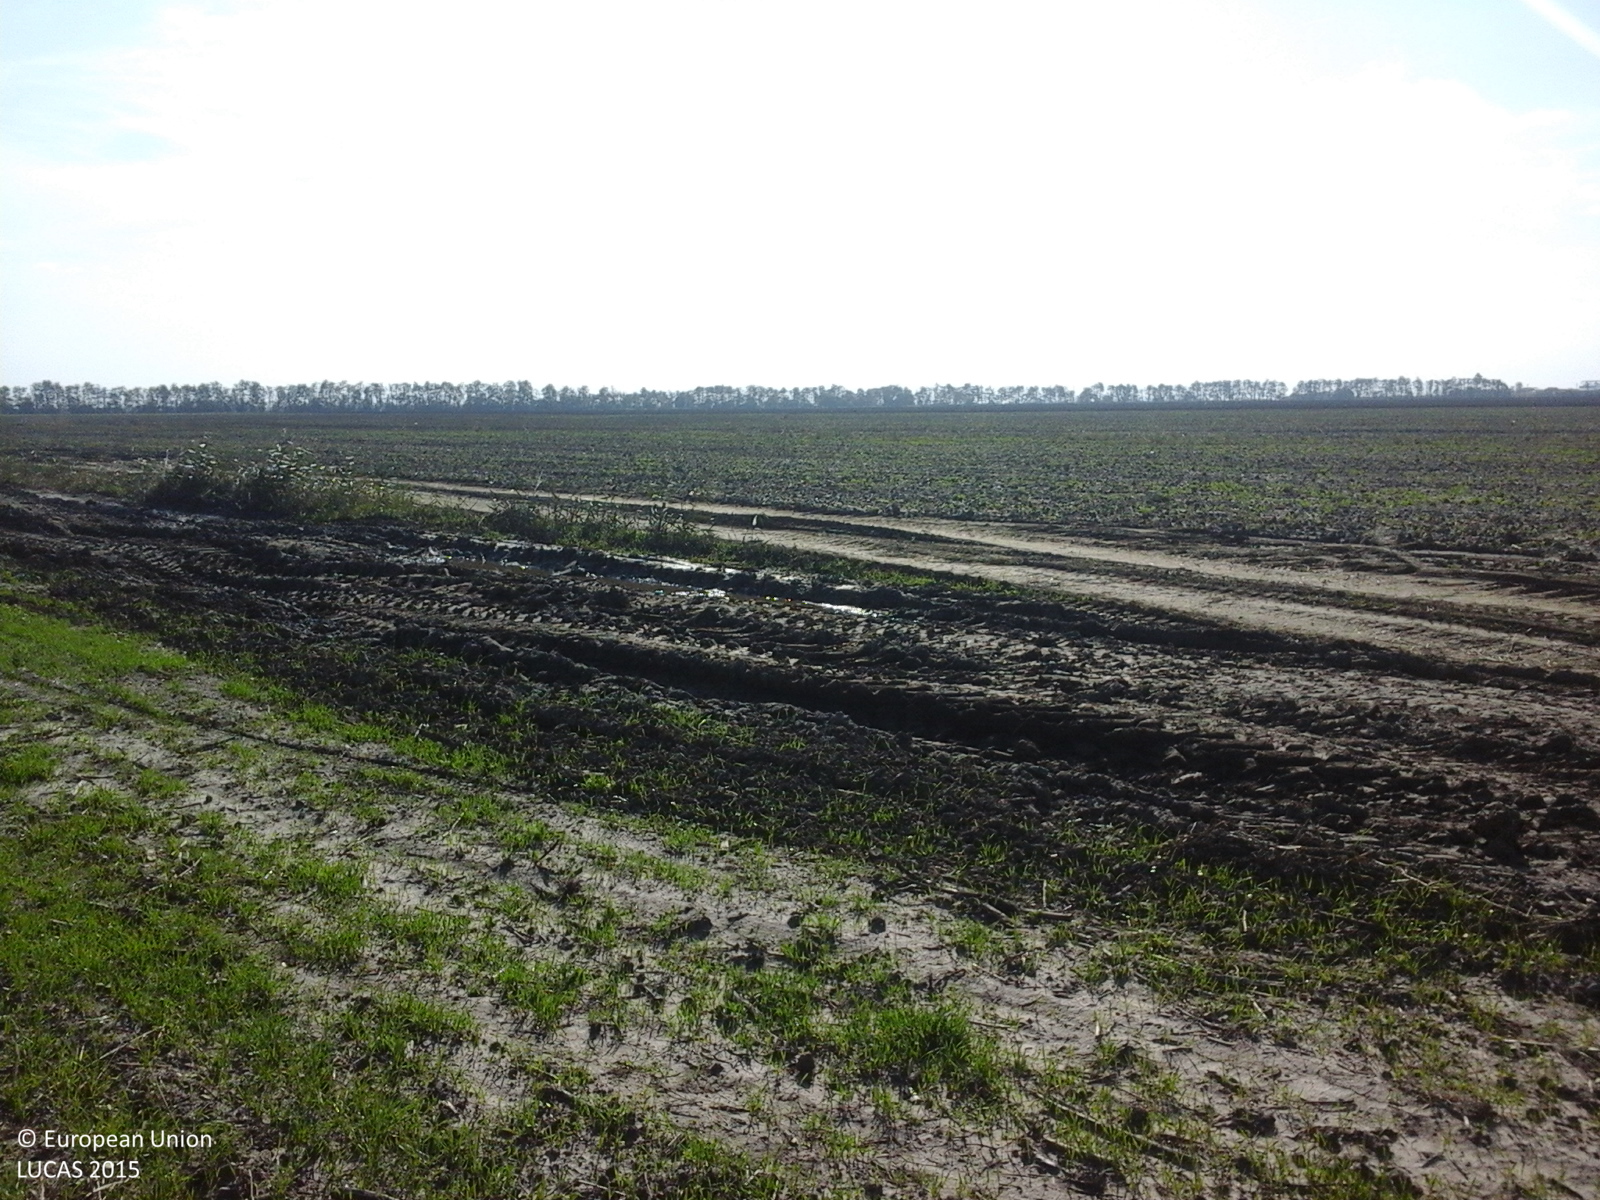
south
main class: Cropland
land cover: Common wheat
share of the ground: 10 - 25 %
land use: Agriculture (excluding fallow land and kitchen gardens)
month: October
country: RO
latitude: 45.4627
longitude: 27.4029
